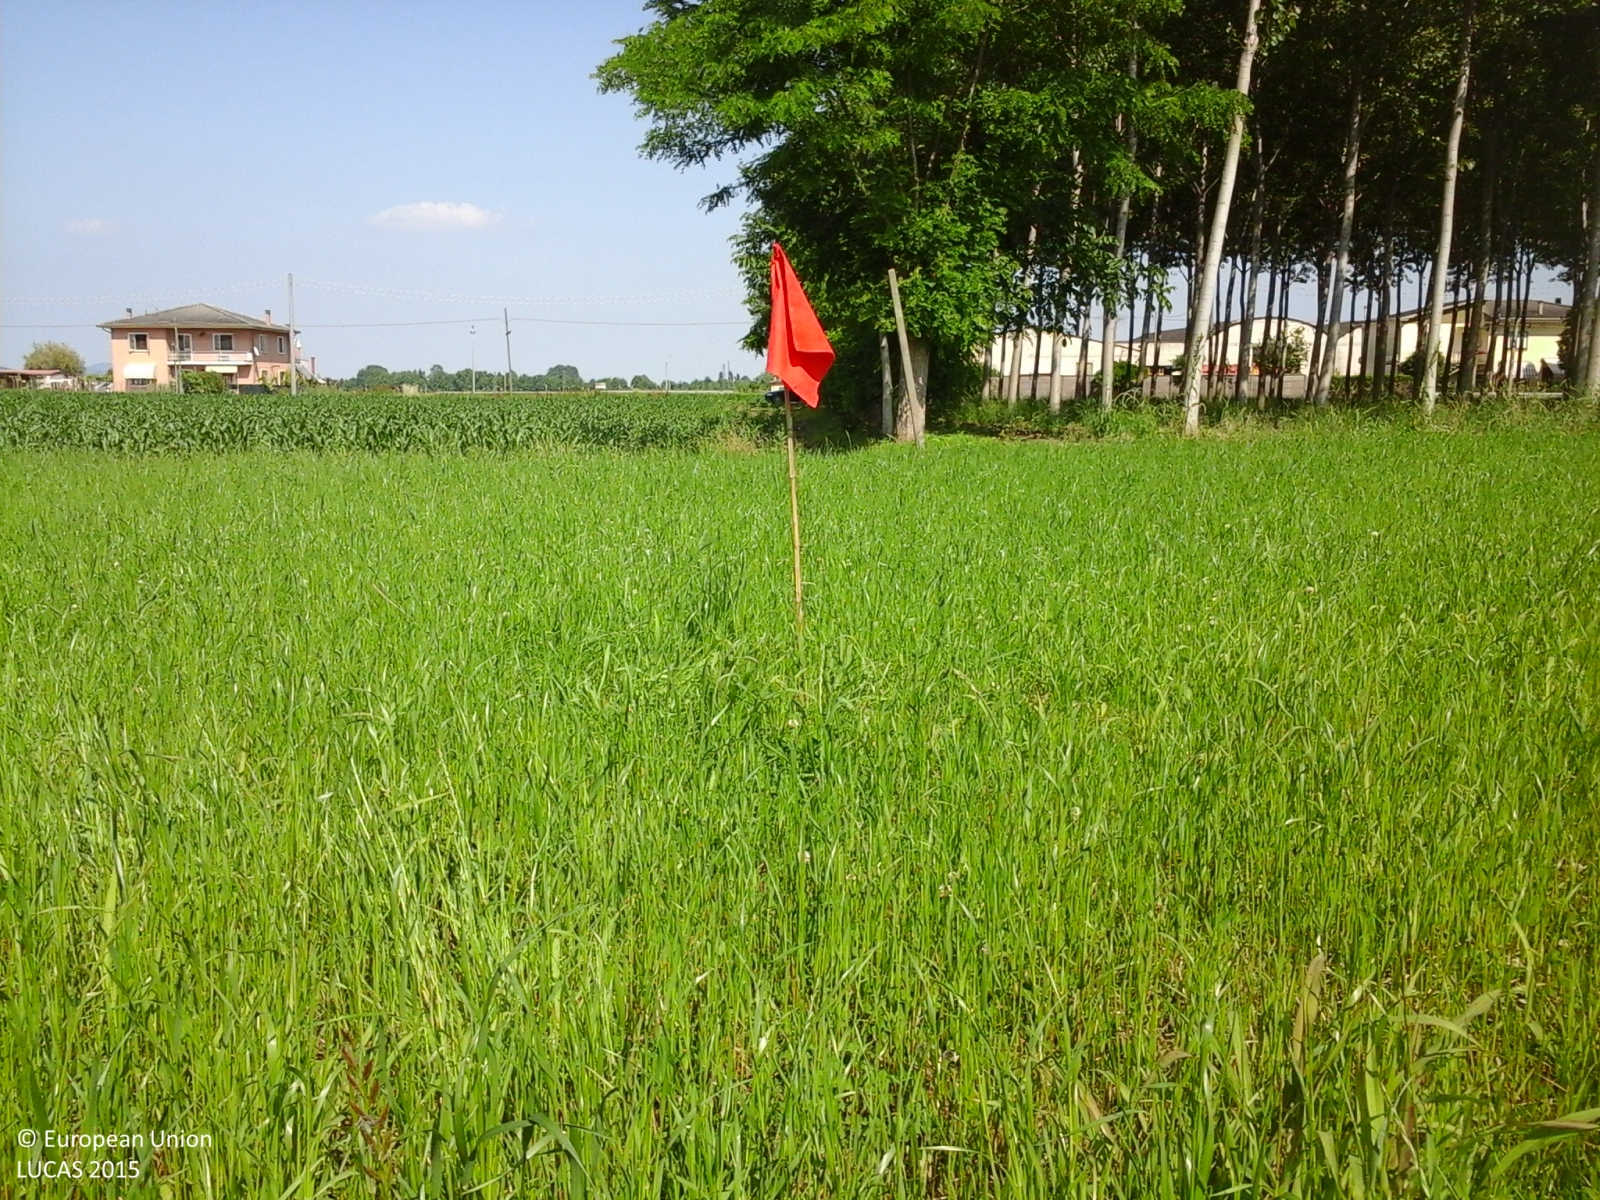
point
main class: Grassland
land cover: Spontaneously vegetated surfaces
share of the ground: > 75 %
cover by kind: herbaceous plants 100 %
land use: Agriculture (excluding fallow land and kitchen gardens)
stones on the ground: < 10 %
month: May
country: IT
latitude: 45.2044
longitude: 11.5631
